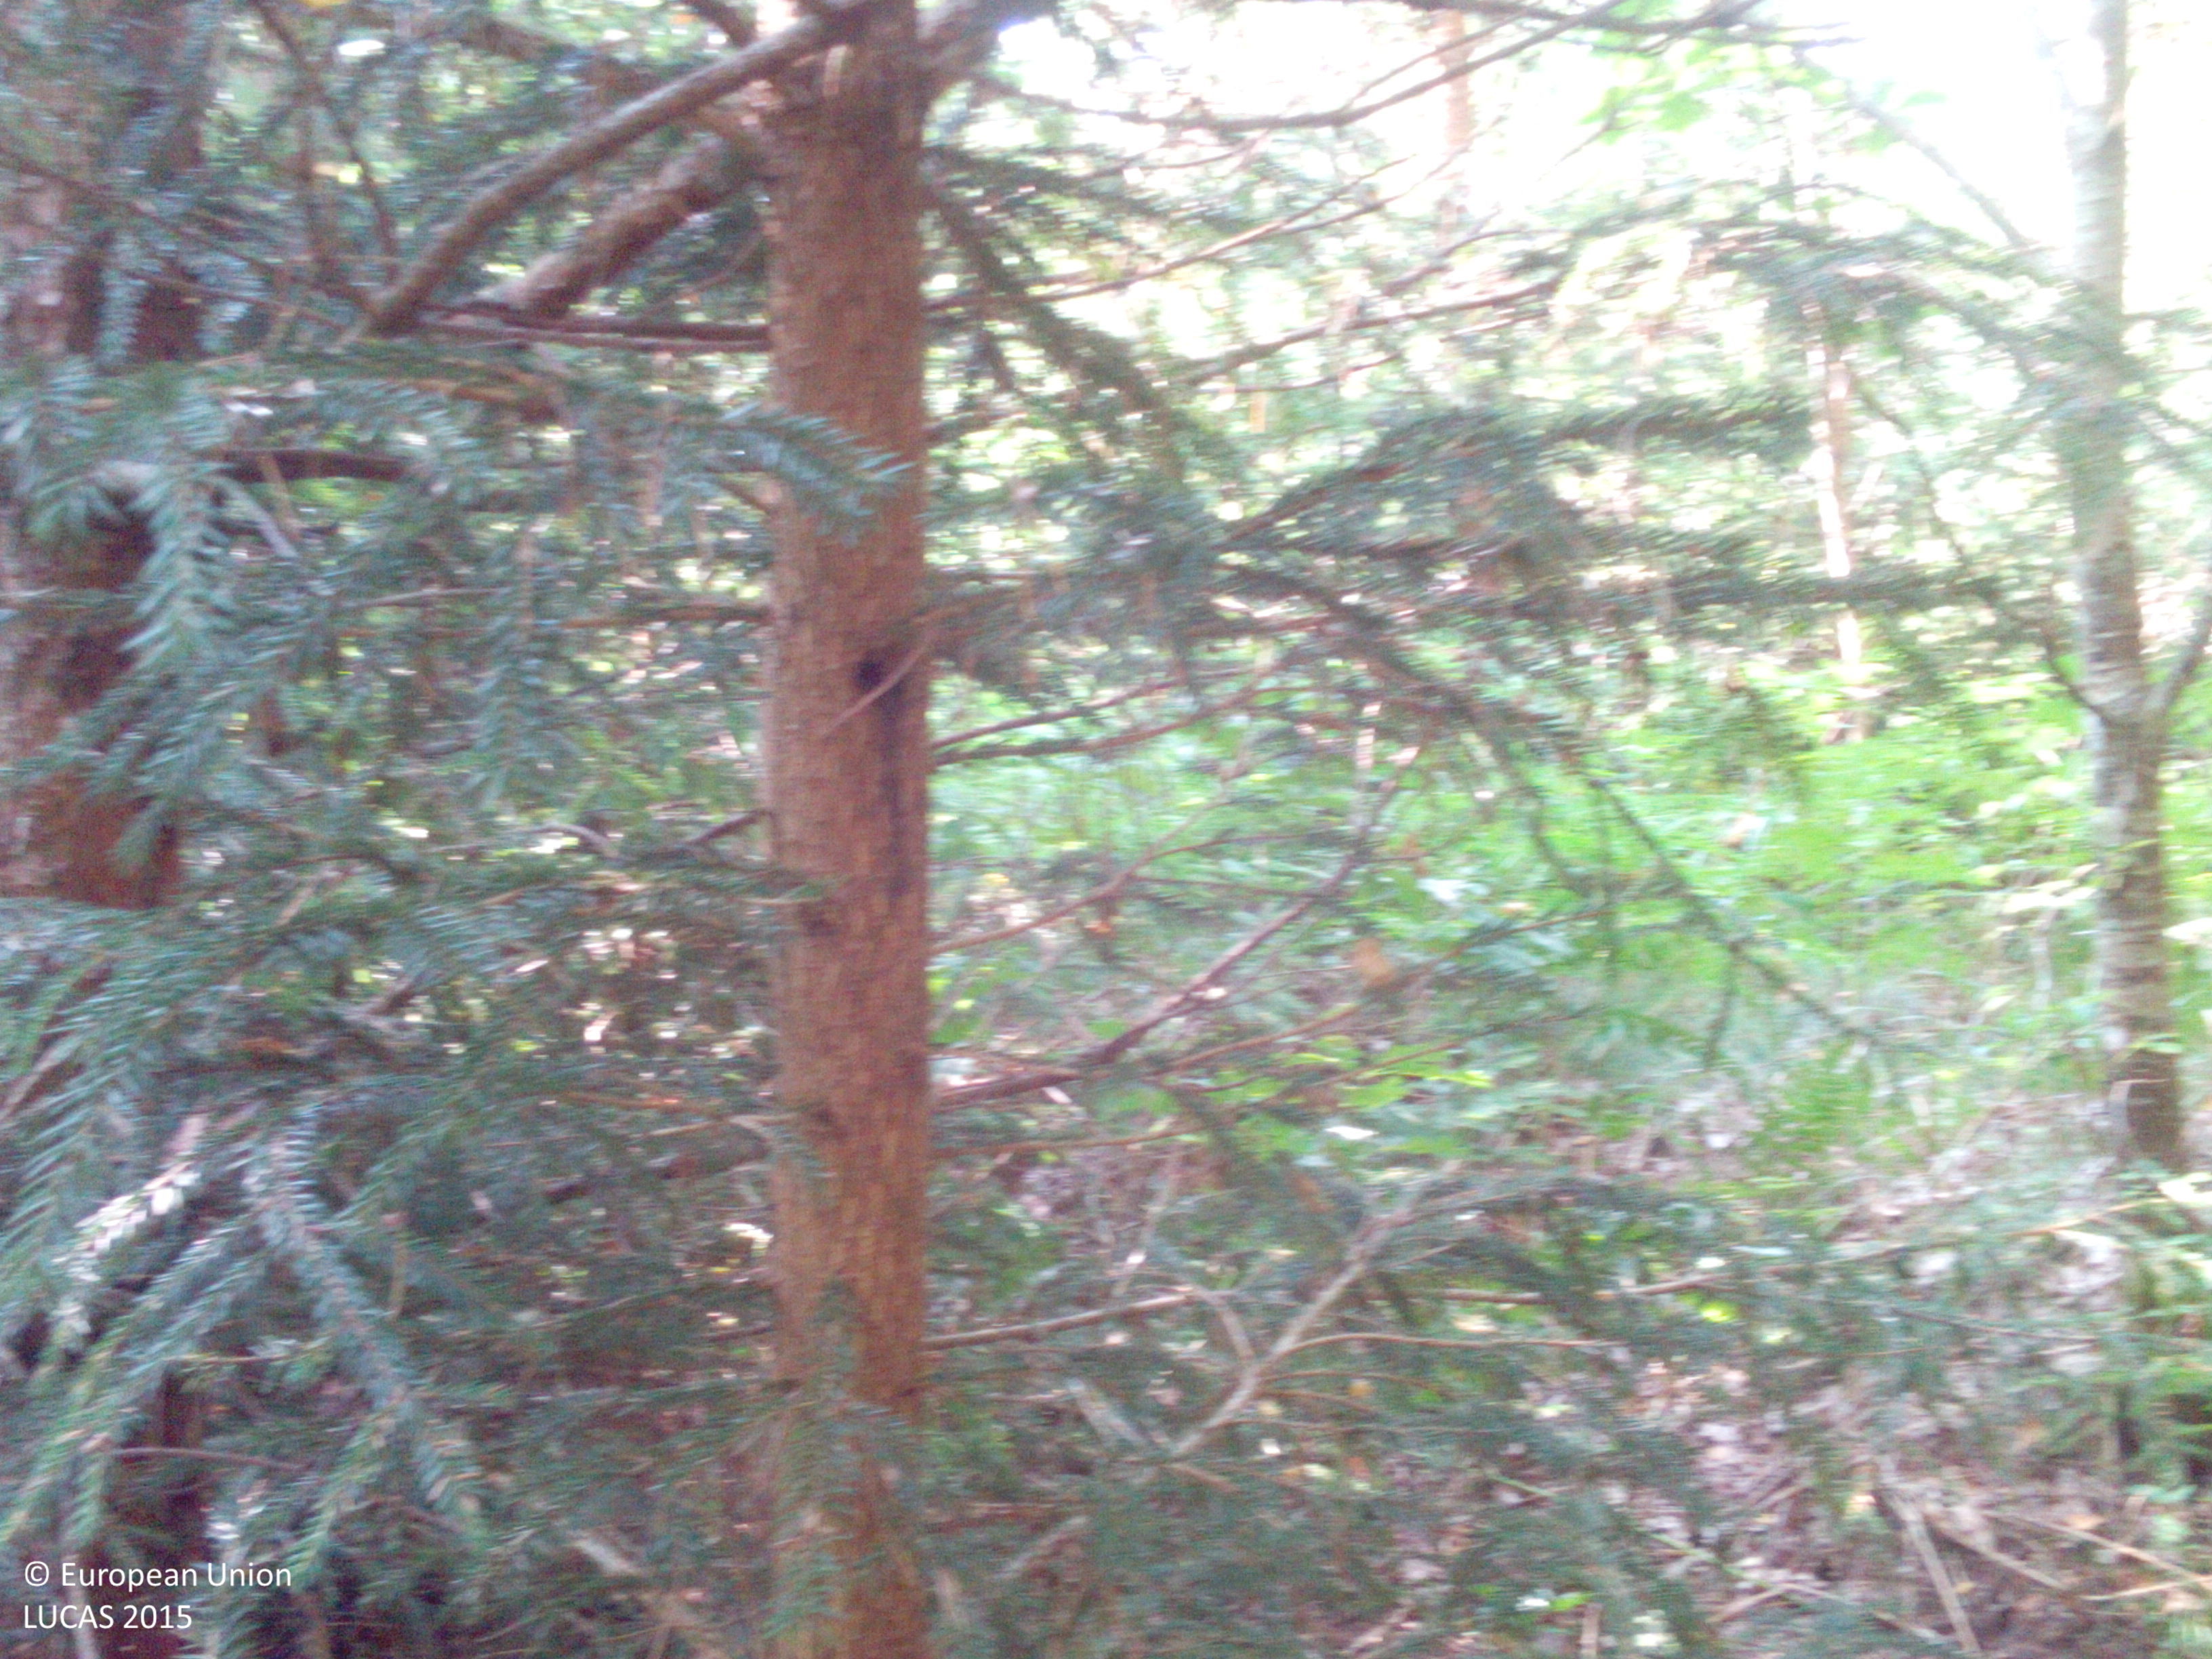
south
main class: Woodland
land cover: Other mixed woodland
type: hemiboreal forest and nemoral coniferous forest and mixed broadleaved-coniferous forest
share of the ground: > 75 %
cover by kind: coniferous forest trees 60 %, broadleaved forest trees 30 %, herbaceous plants 10 %
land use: Forestry
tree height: > 5 m
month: August
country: LV
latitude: 57.0249
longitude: 21.7899
